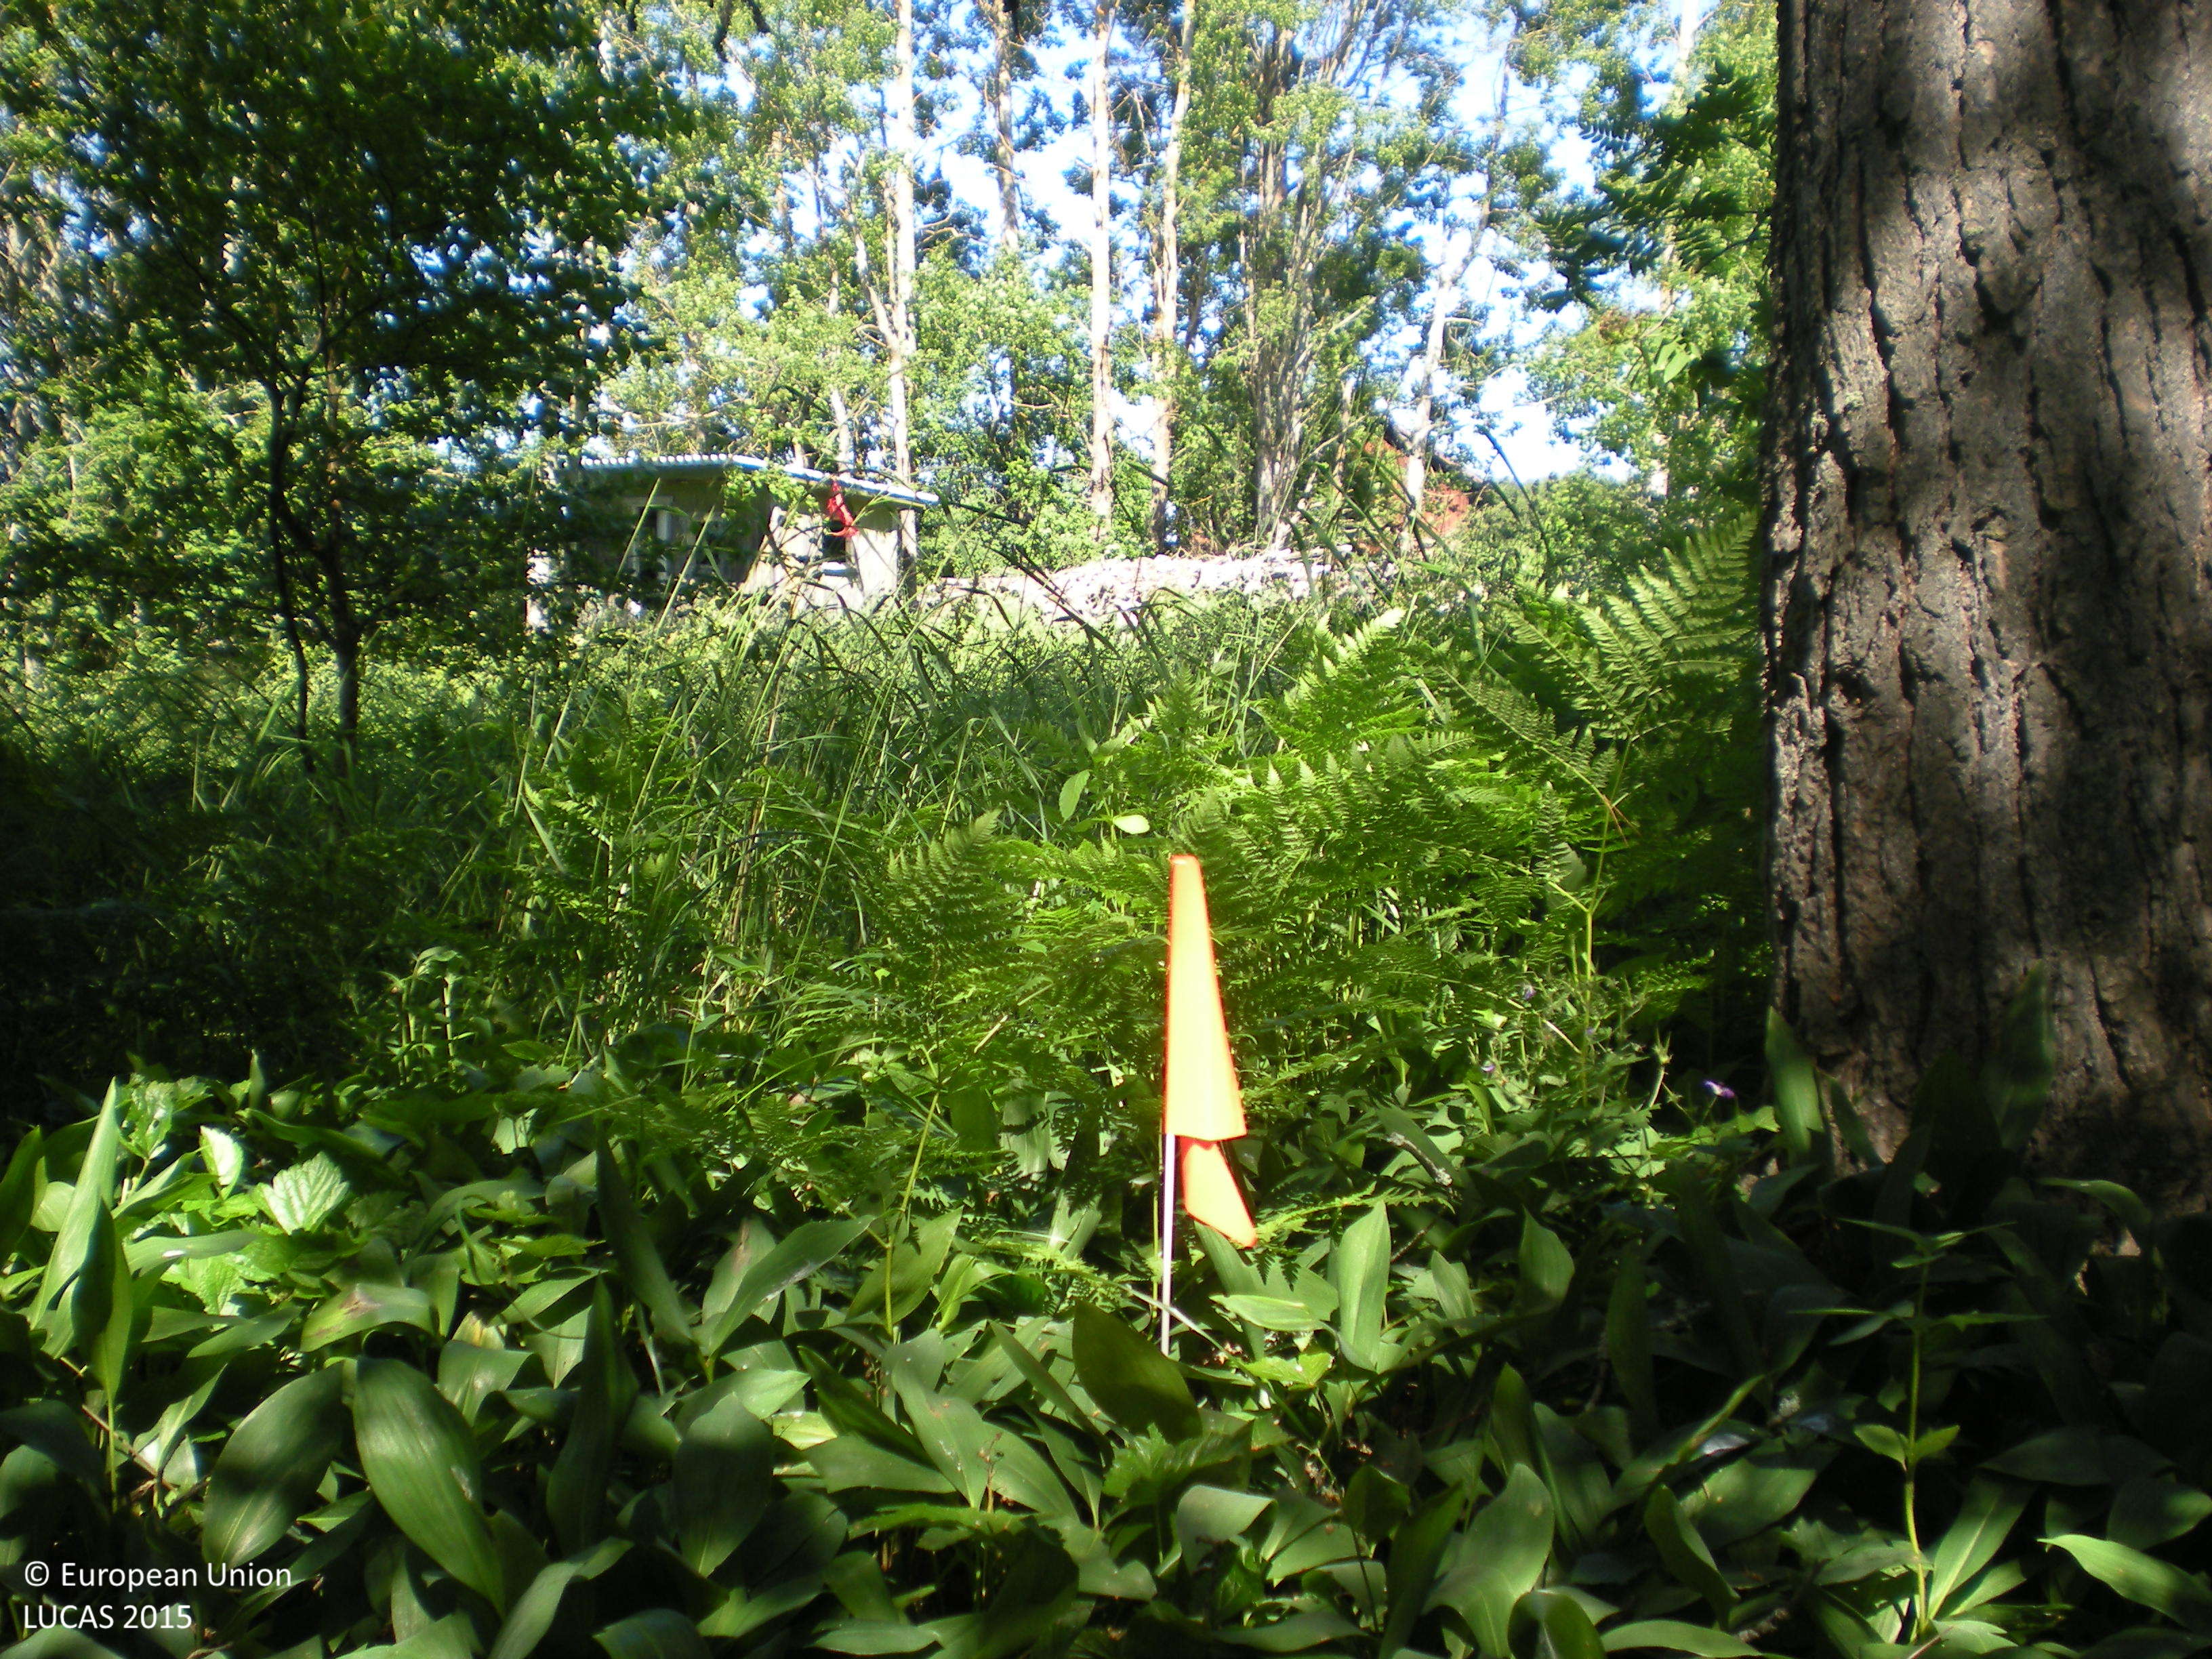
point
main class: Woodland
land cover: Broadleaved woodland
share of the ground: 50 - 75 %
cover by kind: broadleaved forest trees 45 %, herbaceous plants 40 %, shrubs 10 %, coniferous forest trees 5 %
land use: Semi-natural and natural areas not in use
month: July
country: SE
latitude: 60.4559
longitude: 17.7552
